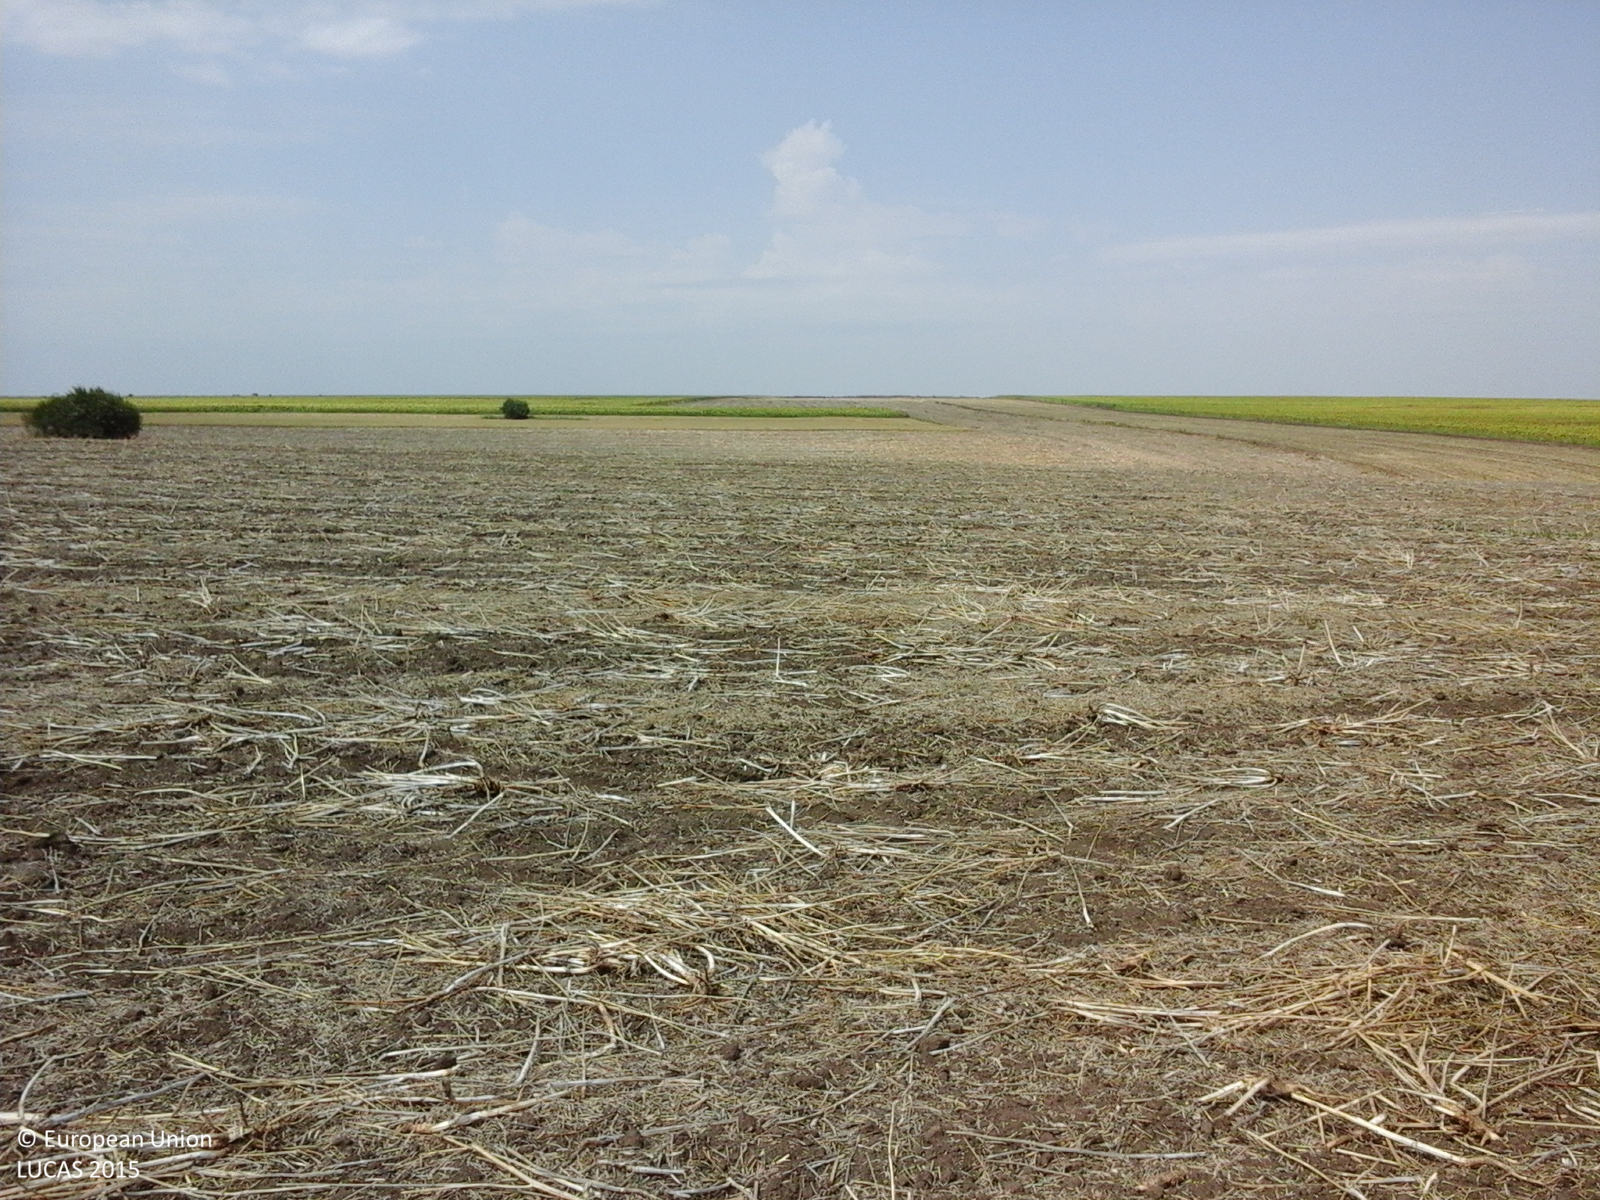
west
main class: Cropland
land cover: Rape and turnip rape
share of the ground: 10 - 25 %
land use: Agriculture (excluding fallow land and kitchen gardens)
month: August
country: RO
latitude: 43.9665
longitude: 28.3728
